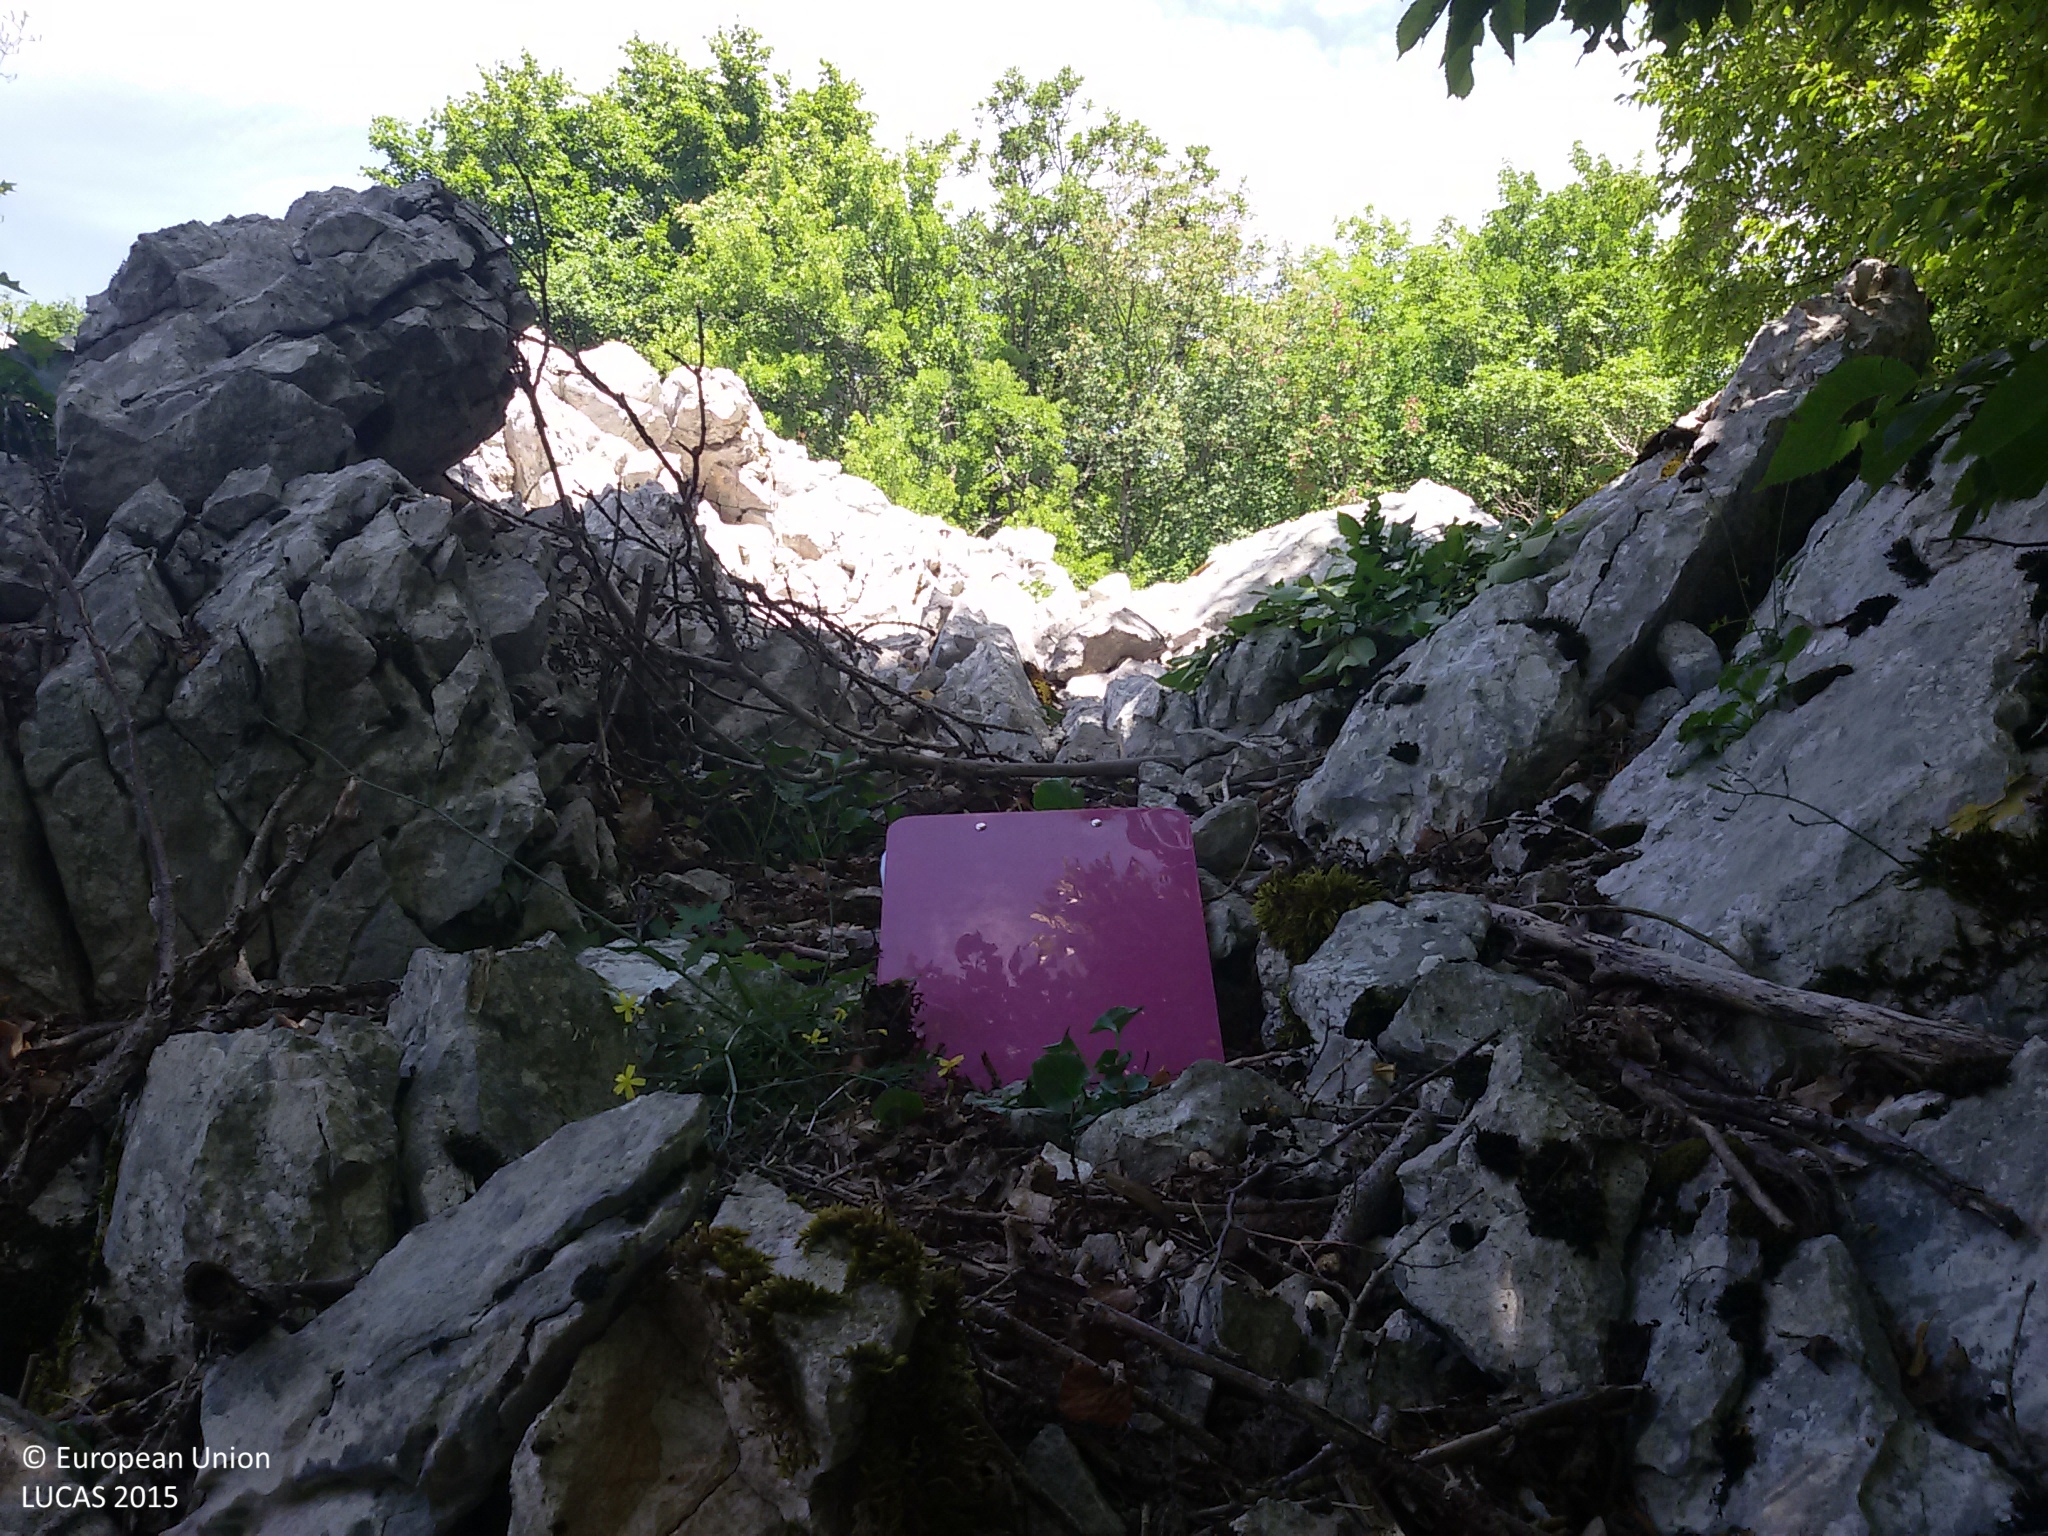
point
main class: Woodland
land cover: Broadleaved woodland
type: mountainous beech forest
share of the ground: 50 - 75 %
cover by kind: broadleaved forest trees 50 %, consolidated bare surface 20 %, shrubs 10 %, lichens and mosses 10 %, herbaceous plants 5 %, unconsolidated bare surface 5 %
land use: Semi-natural and natural areas not in use
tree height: > 5 m
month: June
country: HR
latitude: 44.5610
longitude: 15.5962
